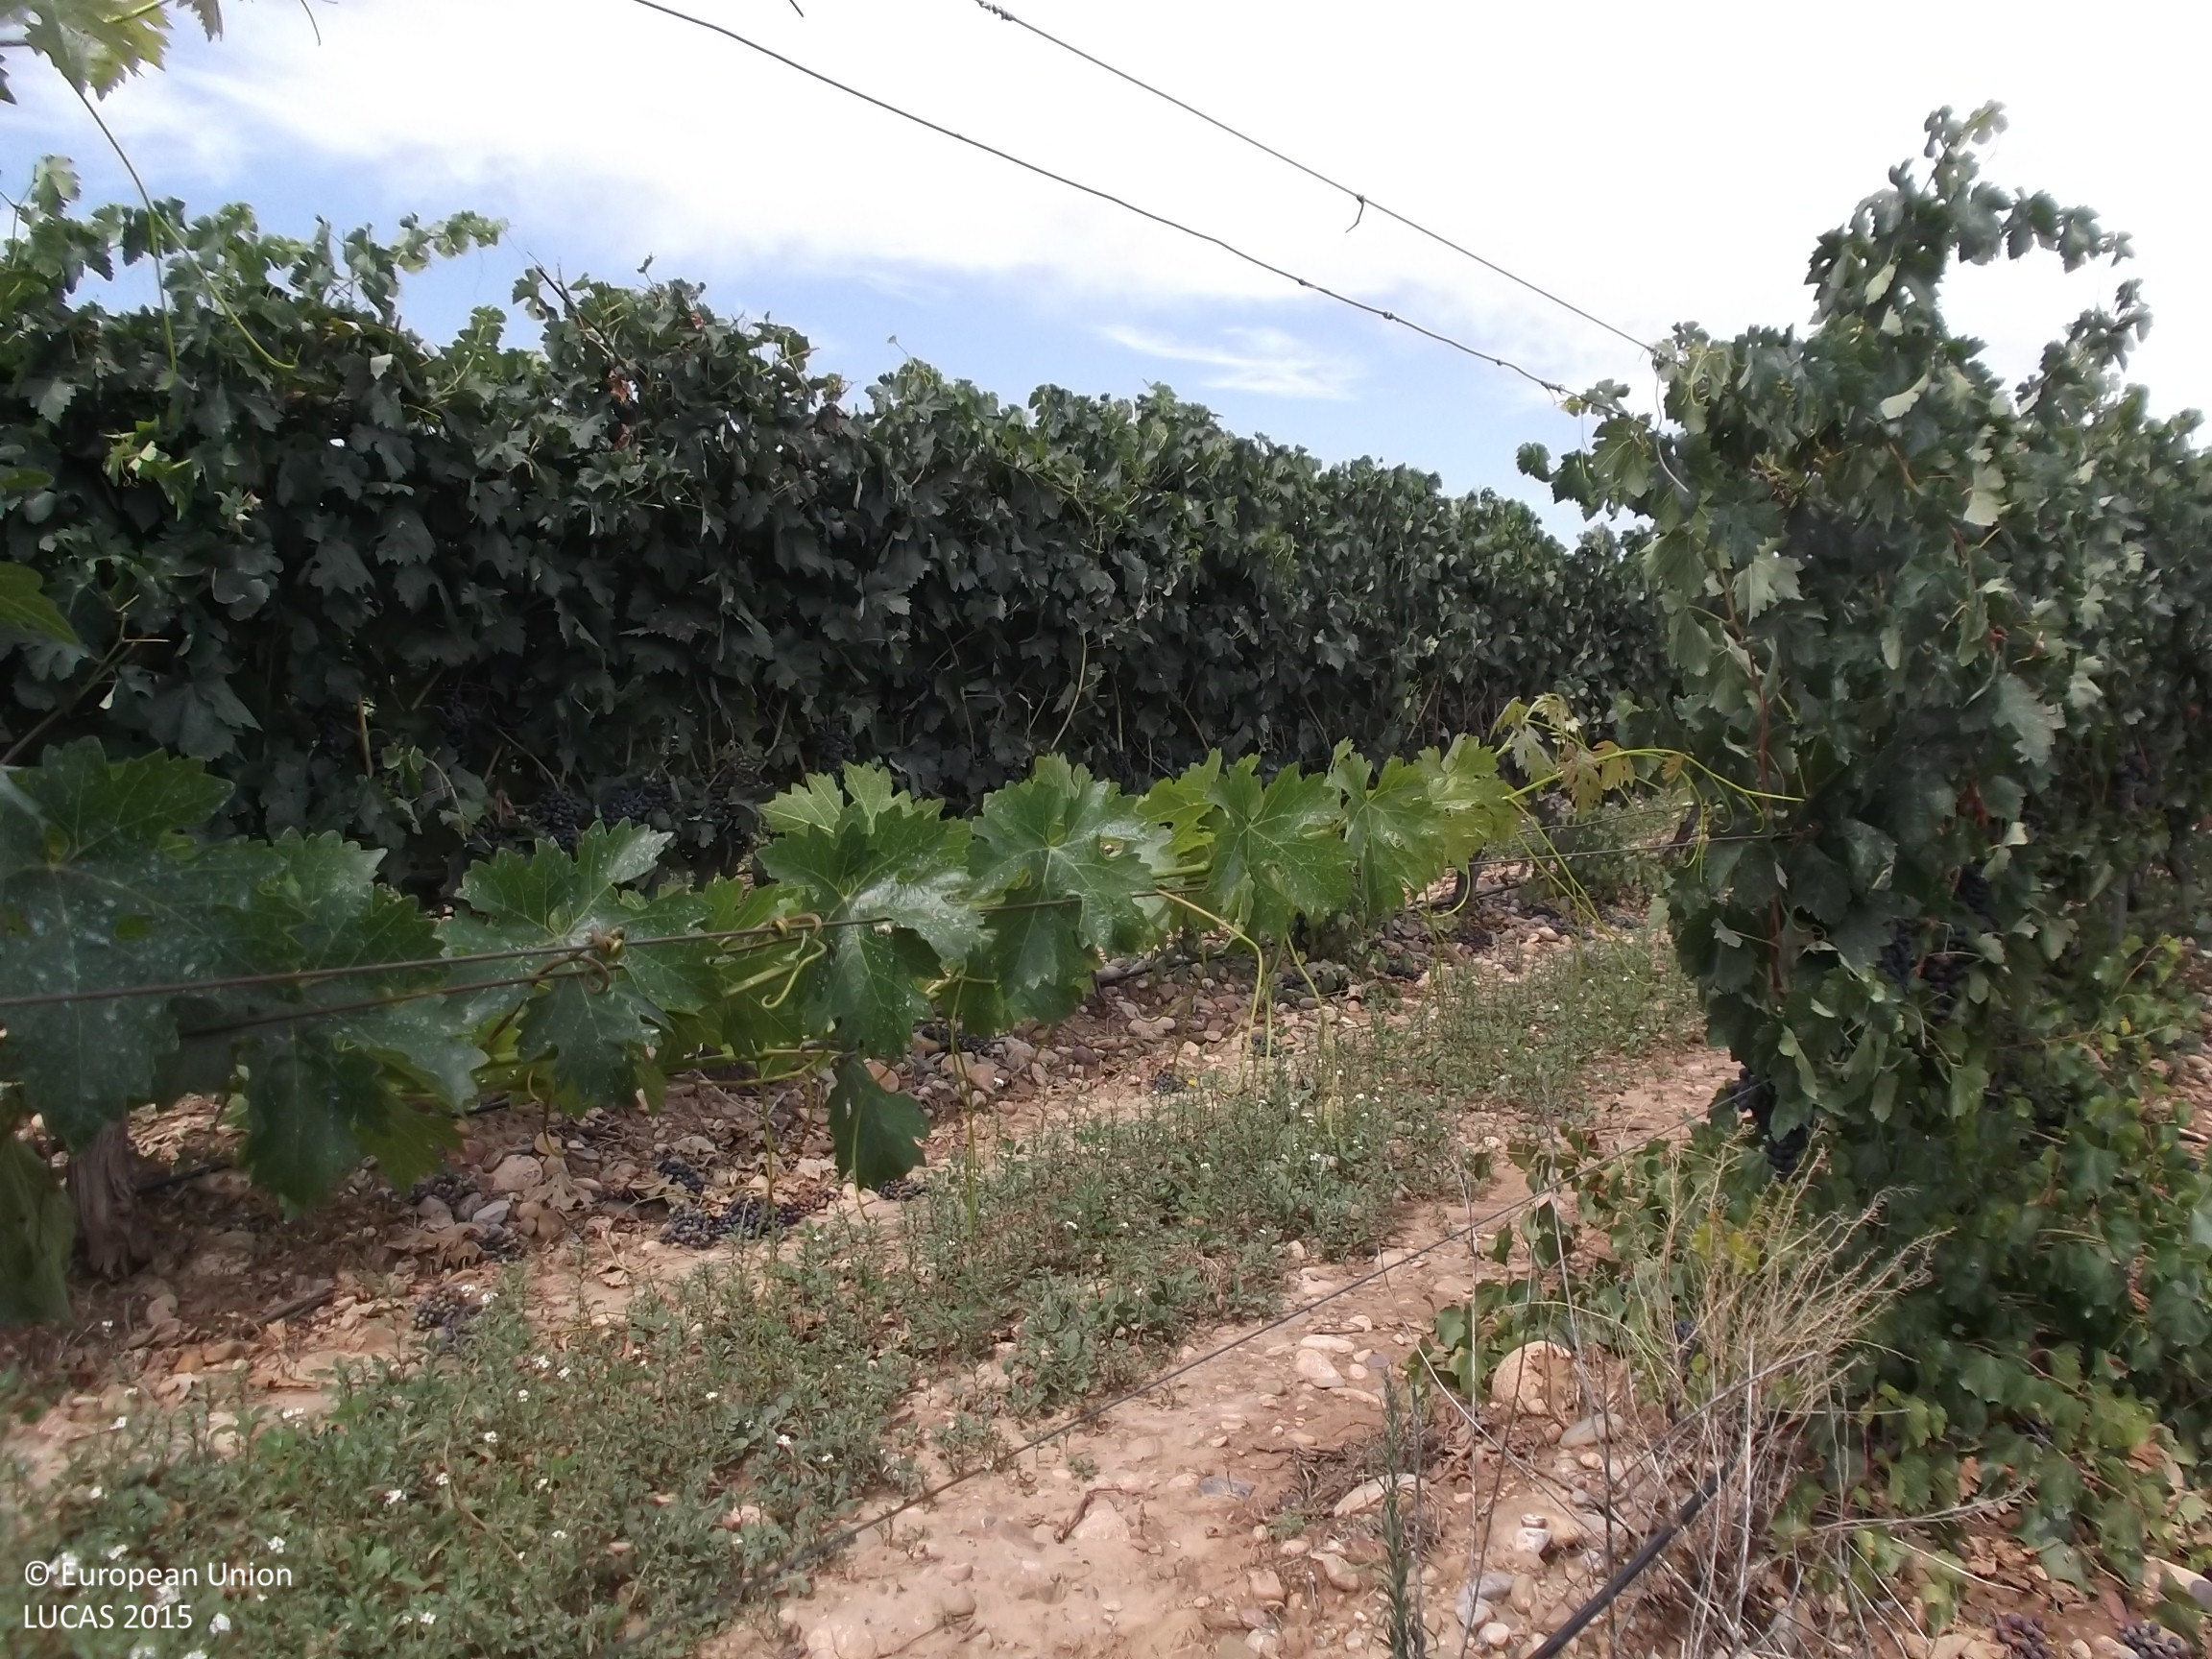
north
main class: Cropland
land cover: Vineyards
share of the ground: 10 - 25 %
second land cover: Other bare soil
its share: > 75 %
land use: Agriculture (excluding fallow land and kitchen gardens)
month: August
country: ES
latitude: 42.4293
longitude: -2.1595
